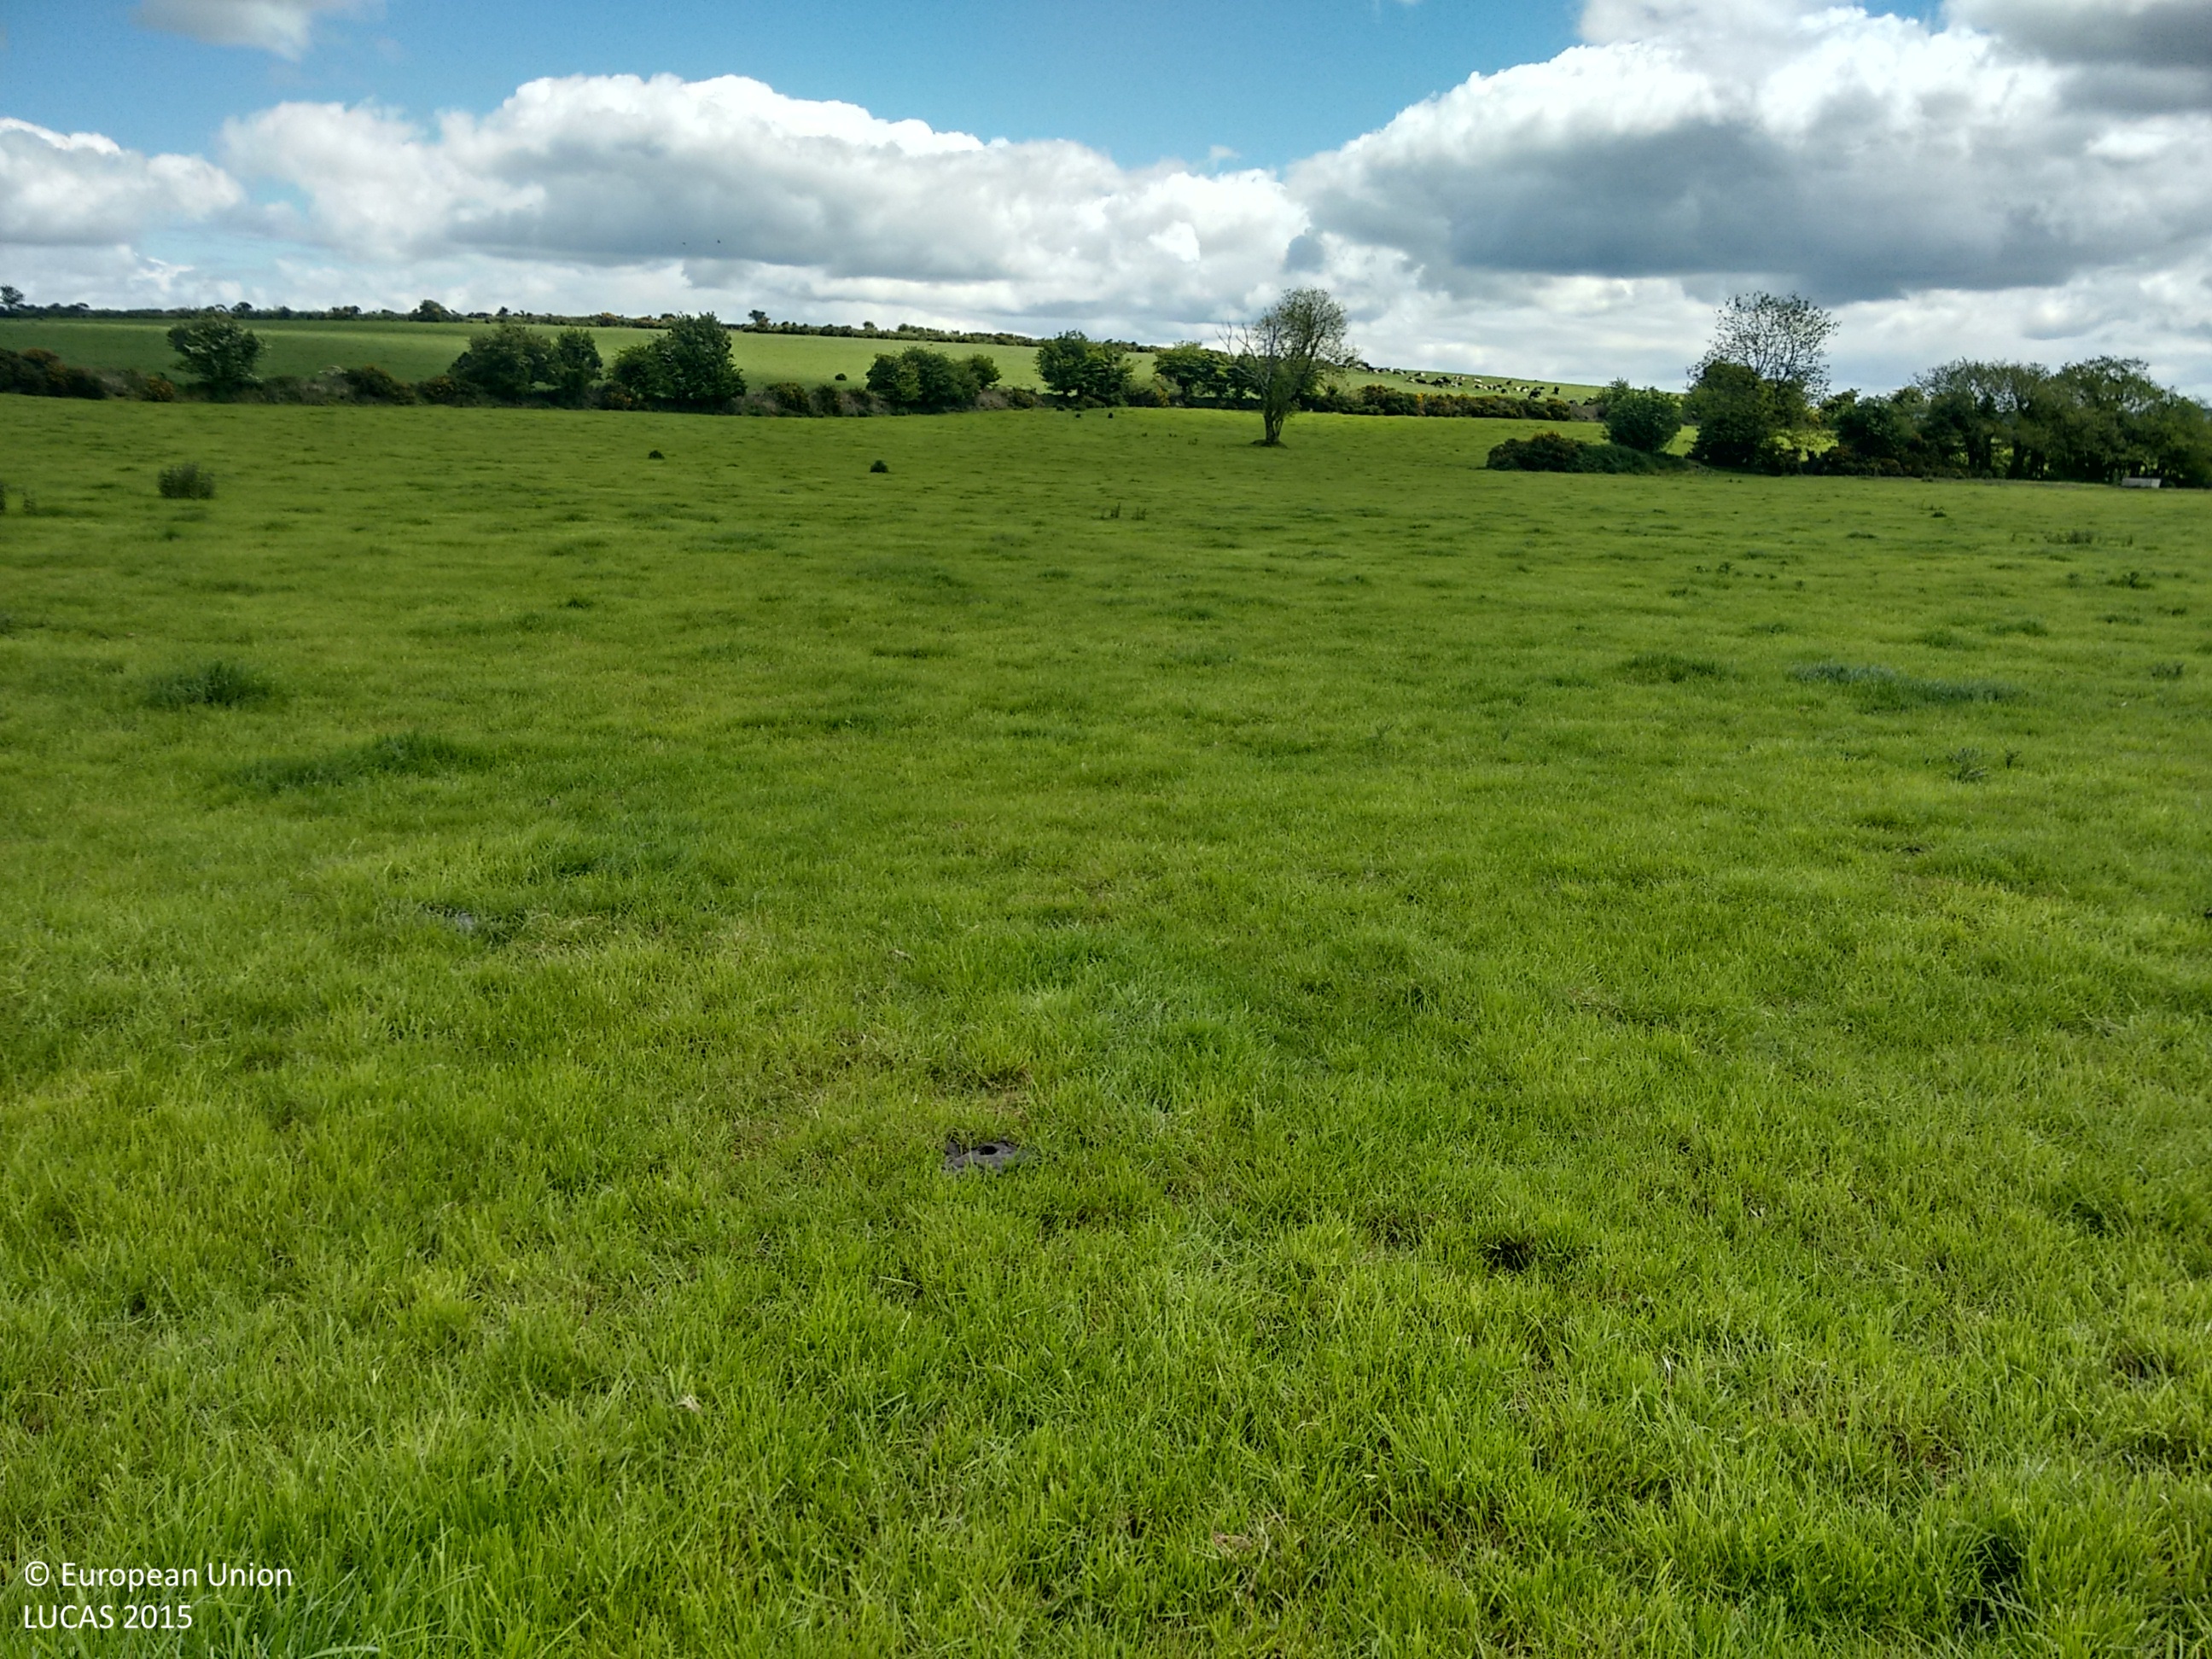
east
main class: Grassland
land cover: Grassland without tree/shrub cover
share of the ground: > 75 %
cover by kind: herbaceous plants 100 %
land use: Agriculture (excluding fallow land and kitchen gardens)
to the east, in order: Grassland without tree/shrub cover; Single bushes/trees; Grassland without tree/shrub cover; Fences; Broadleaved woodland; Fences; Grassland without tree/shrub cover
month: May
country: IE
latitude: 51.8229
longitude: -8.7601
